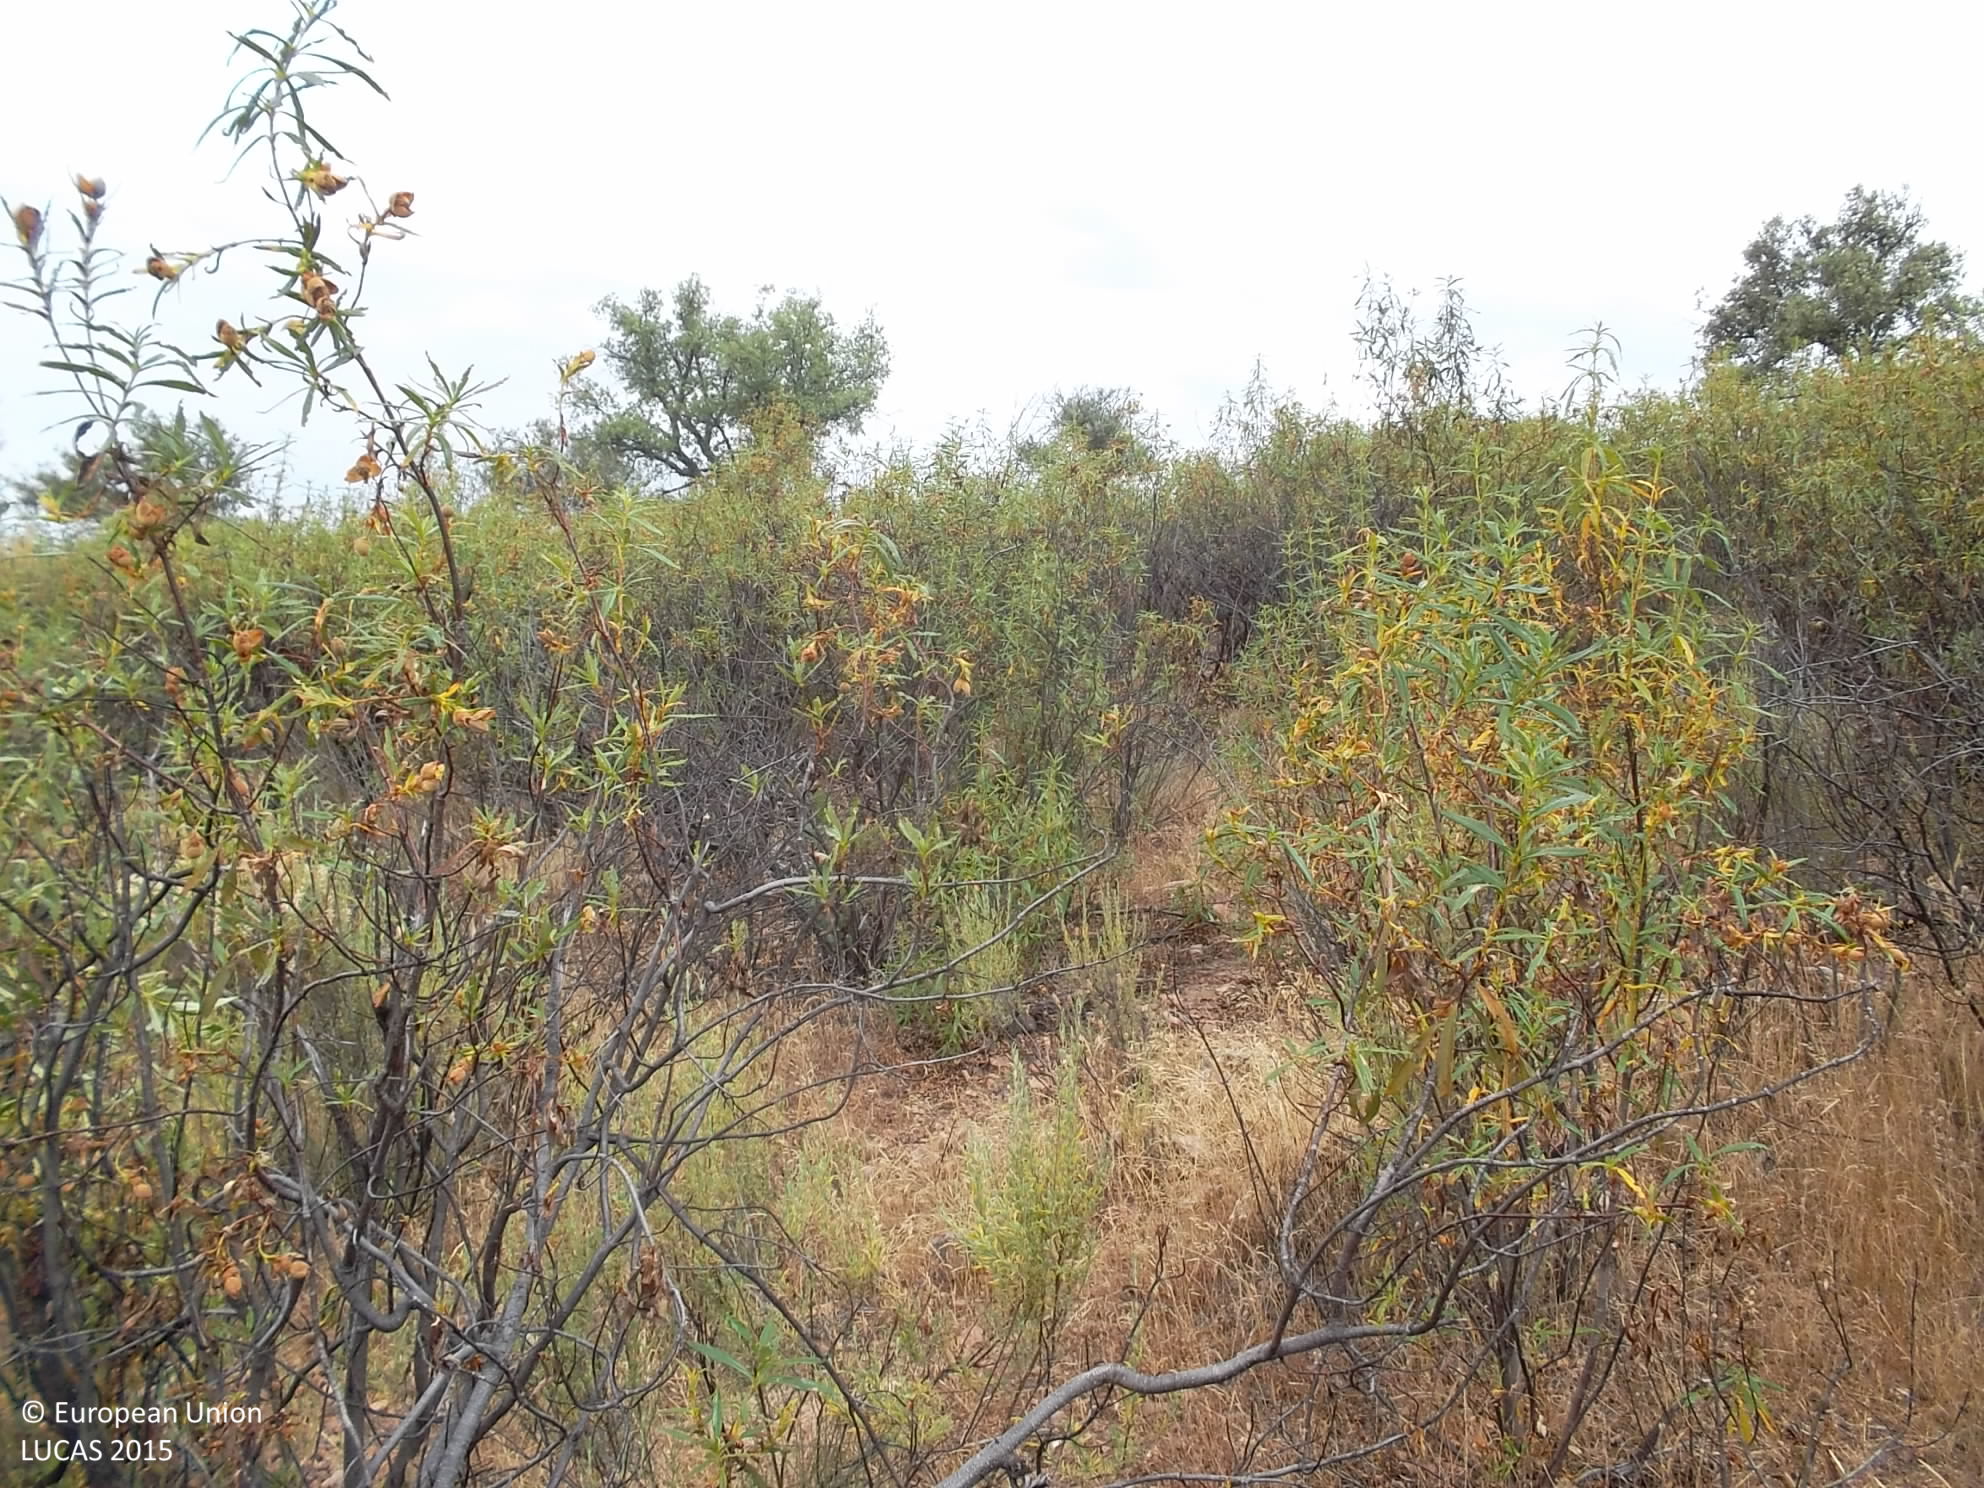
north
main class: Woodland
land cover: Broadleaved woodland
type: broadleaved evergreen forest
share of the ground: 50 - 75 %
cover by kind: shrubs 70 %, broadleaved forest trees 20 %, herbaceous plants 10 %
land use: Semi-natural and natural areas not in use
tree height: > 5 m
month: June
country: ES
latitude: 39.3459
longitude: -4.9979
